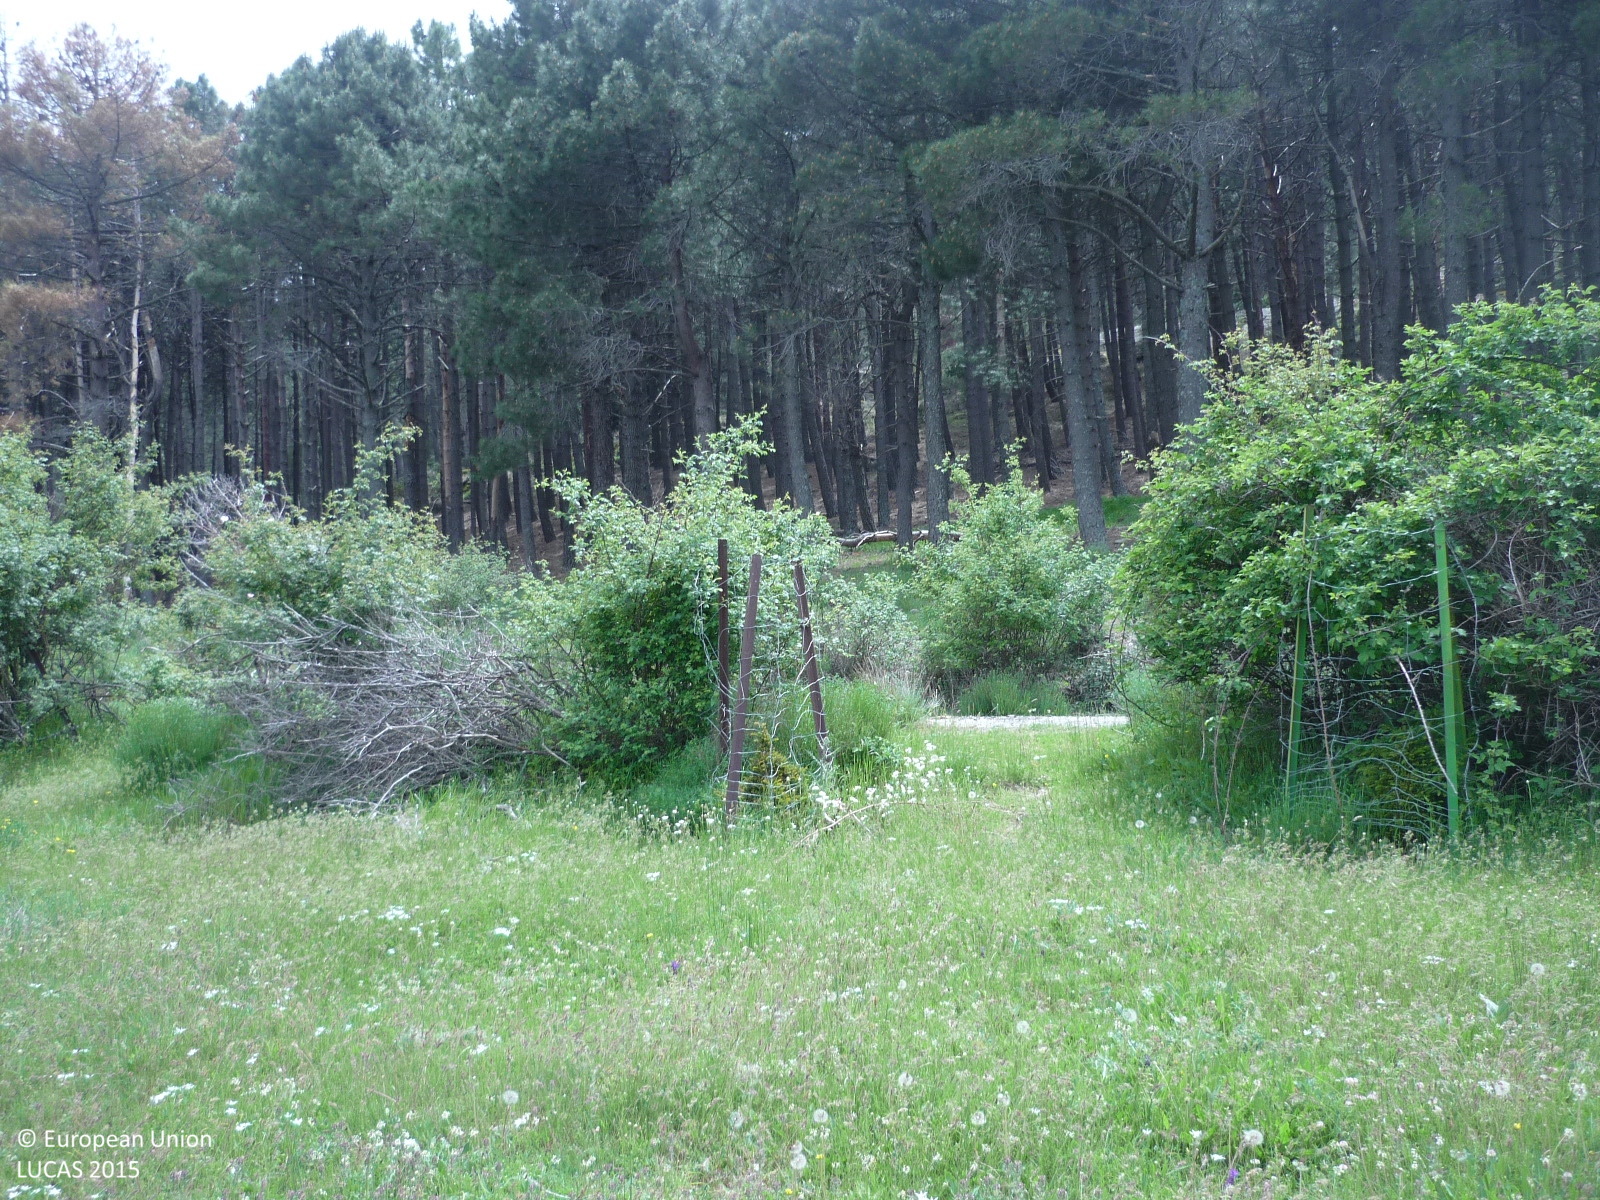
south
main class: Grassland
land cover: Grassland without tree/shrub cover
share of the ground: > 75 %
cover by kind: herbaceous plants 90 %, shrubs 5 %, unconsolidated bare surface 5 %
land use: Agriculture (excluding fallow land and kitchen gardens)
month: May
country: ES
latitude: 40.7546
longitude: -3.9149
